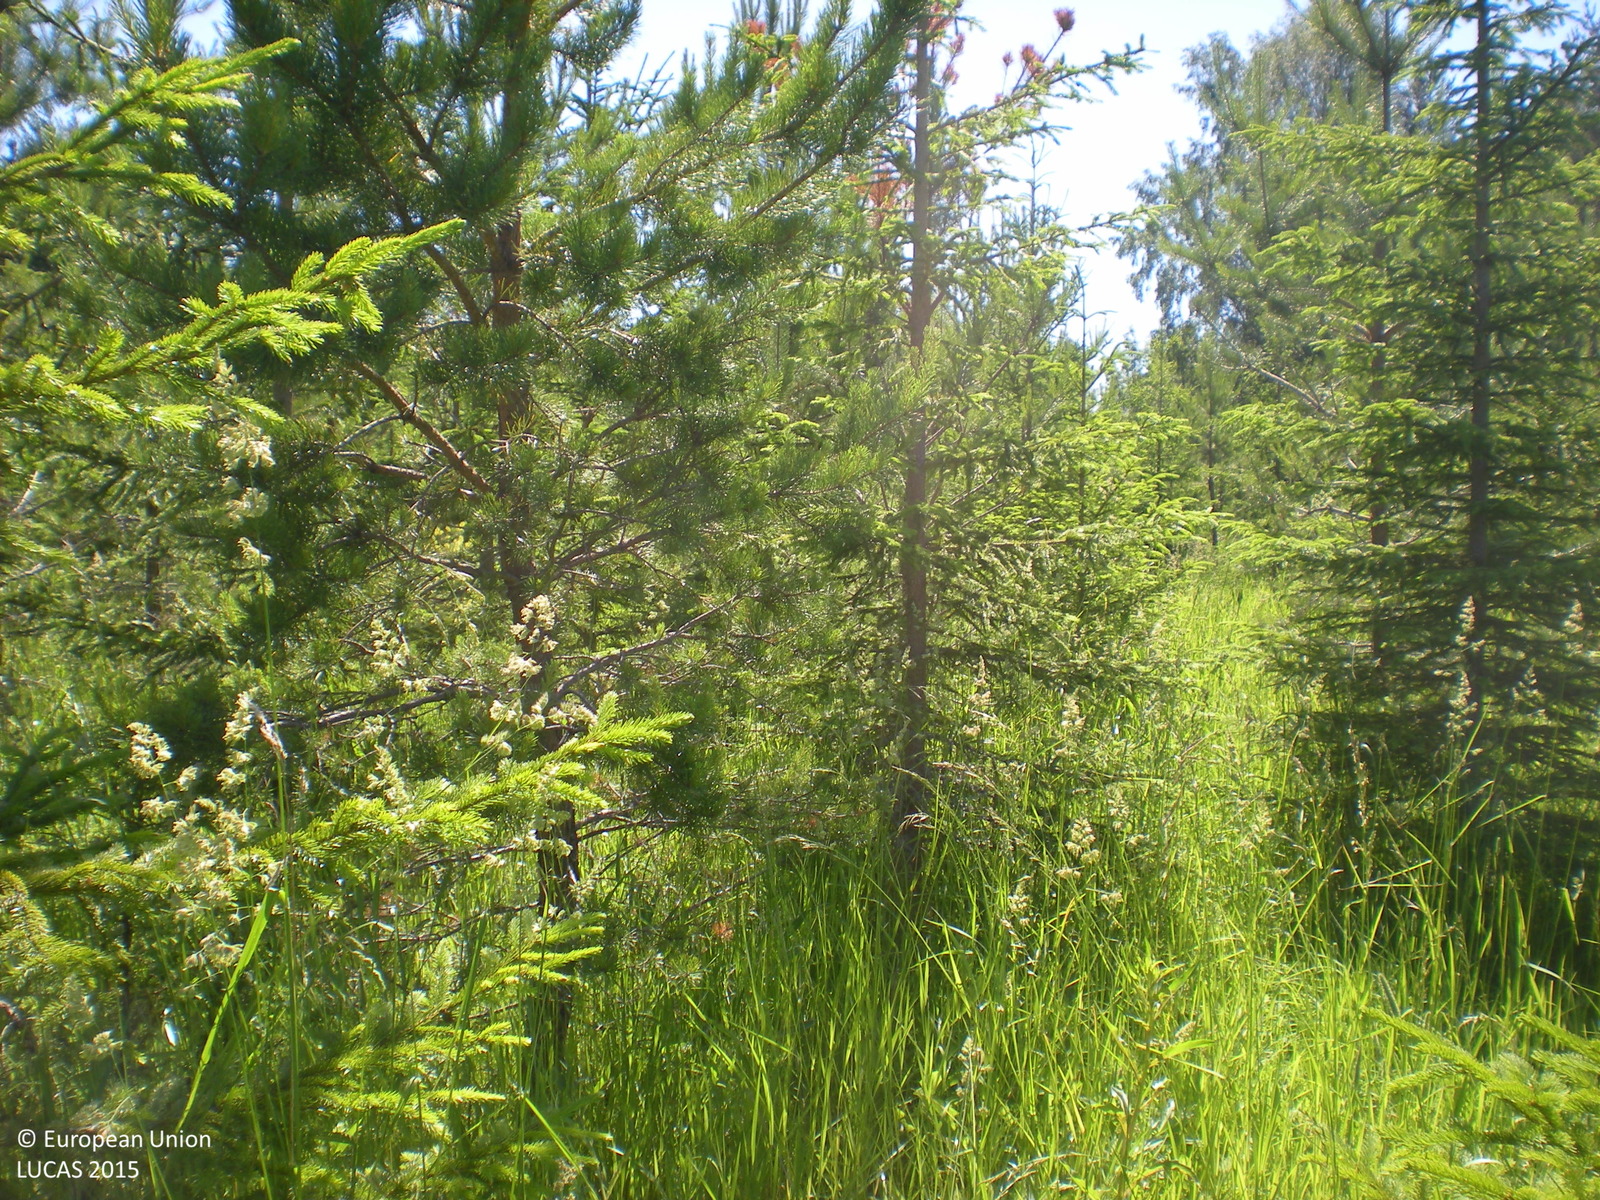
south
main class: Woodland
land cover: Other coniferous woodland
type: boreal forest
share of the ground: 10 - 25 %
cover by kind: herbaceous plants 65 %, coniferous forest trees 35 %
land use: Forestry
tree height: < 5 m
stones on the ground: < 10 %
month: July
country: SE
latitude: 60.4916
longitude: 17.7636
